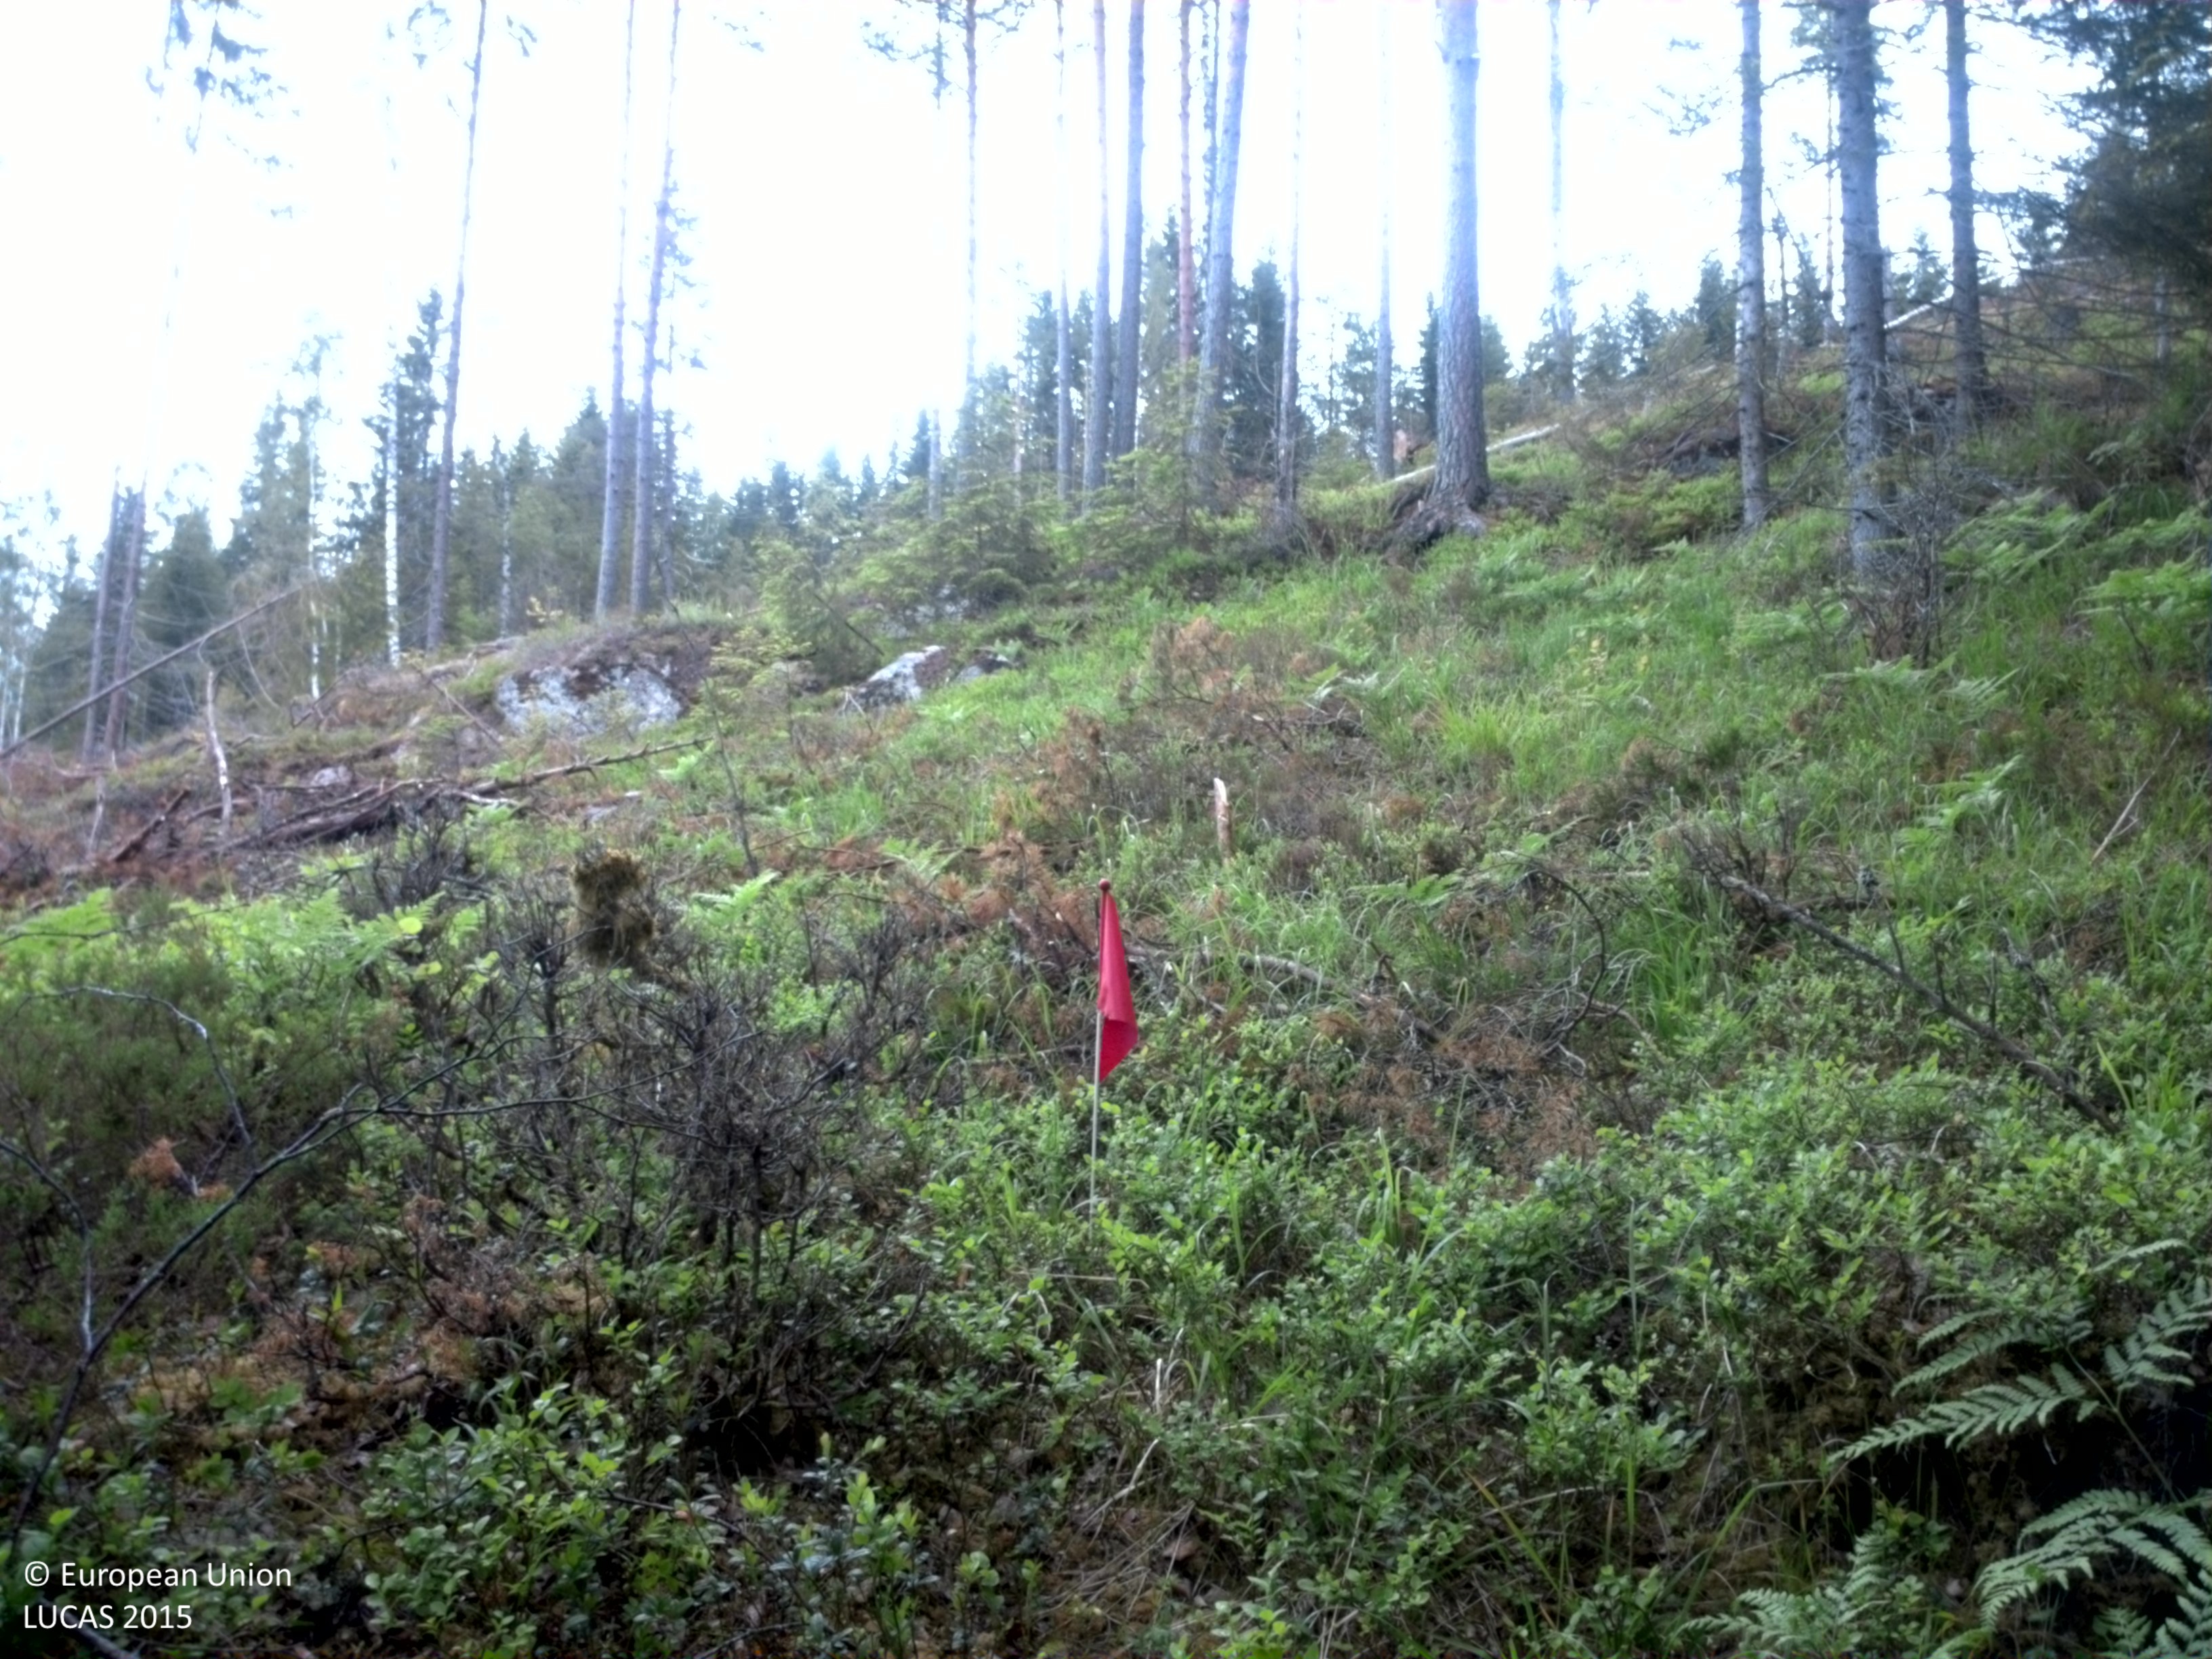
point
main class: Shrubland
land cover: Shrubland with sparse tree cover
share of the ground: 50 - 75 %
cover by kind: shrubs 70 %, lichens and mosses 10 %, consolidated bare surface 10 %, coniferous forest trees 5 %, herbaceous plants 5 %
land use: Forestry
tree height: < 5 m
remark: Clear cut
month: June
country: SE
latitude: 59.7512
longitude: 12.0764
